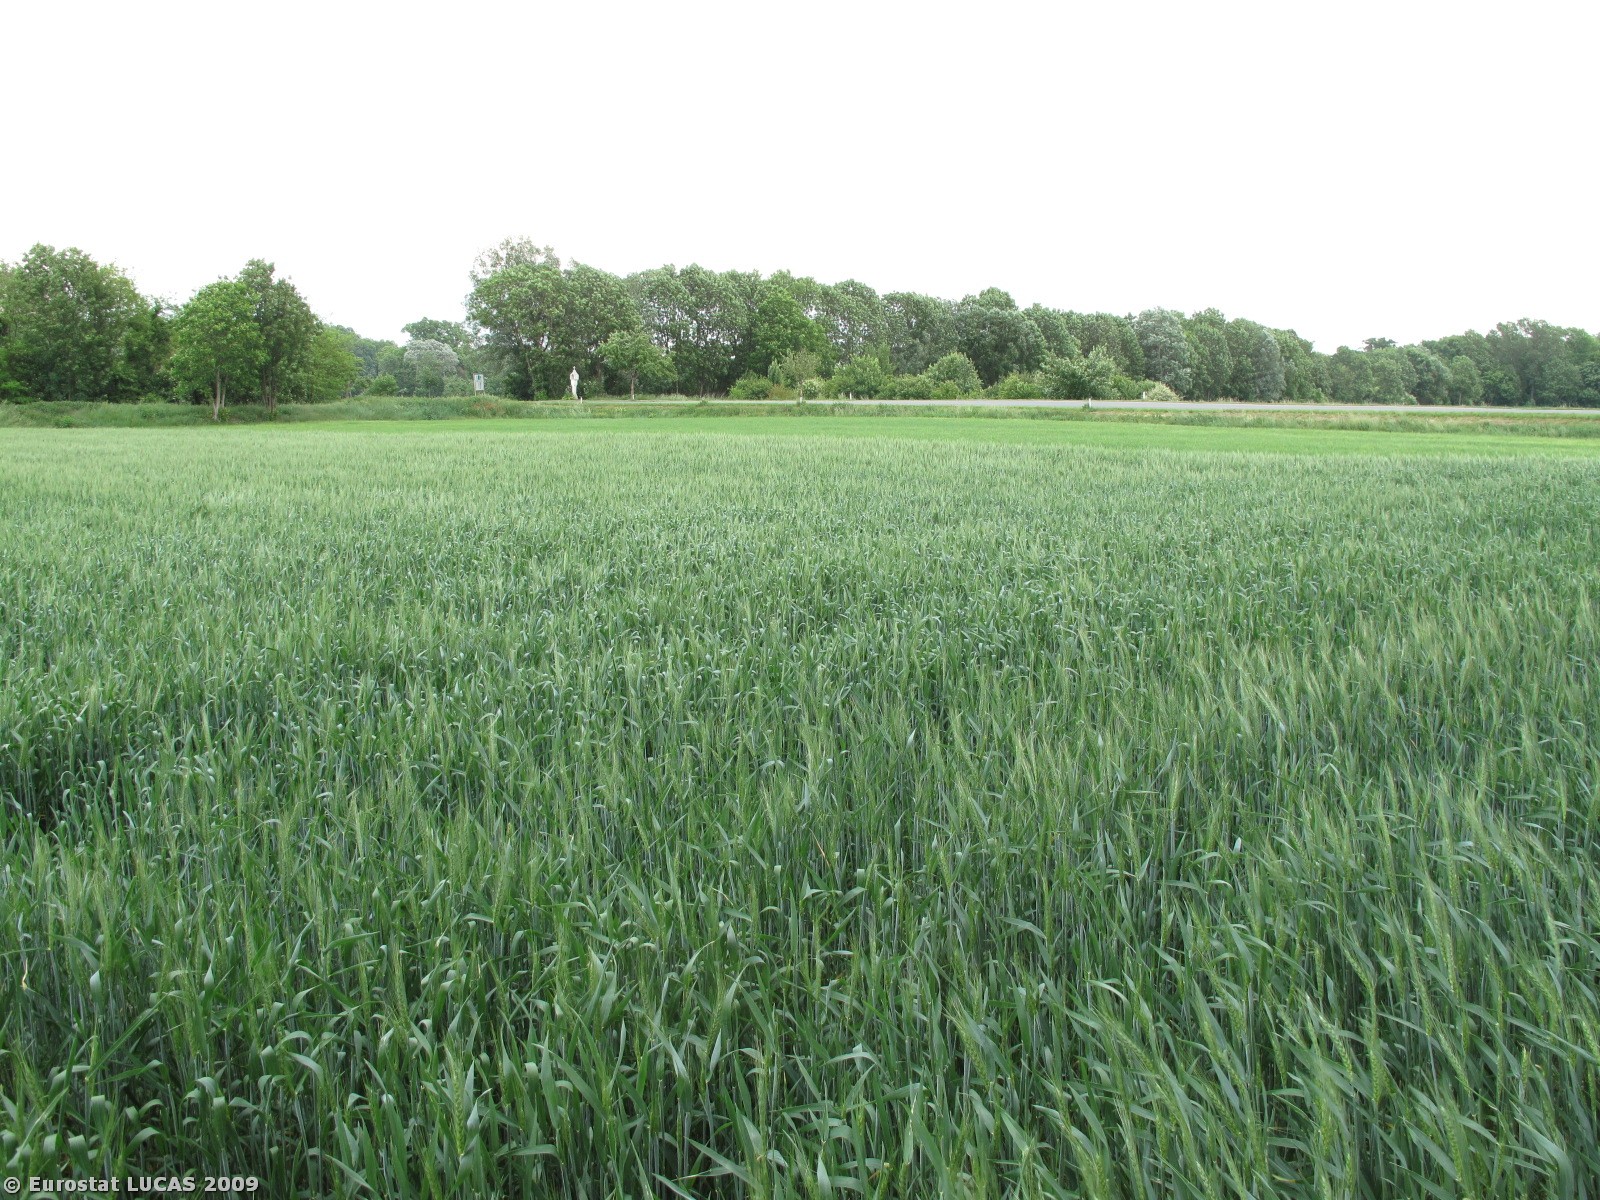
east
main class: Cropland
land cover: Common wheat
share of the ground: > 75 %
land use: Agriculture (excluding fallow land and kitchen gardens)
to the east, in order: Common wheat; Barley; Grass margins; Paved roads, cycling and walking lanes; Grassland with sparse tree/shrub cover; Broadleaved woodland; Rivers and streams; Broadleaved woodland; Tracks; Common wheat
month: May
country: AT
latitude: 48.4021
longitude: 16.0151
